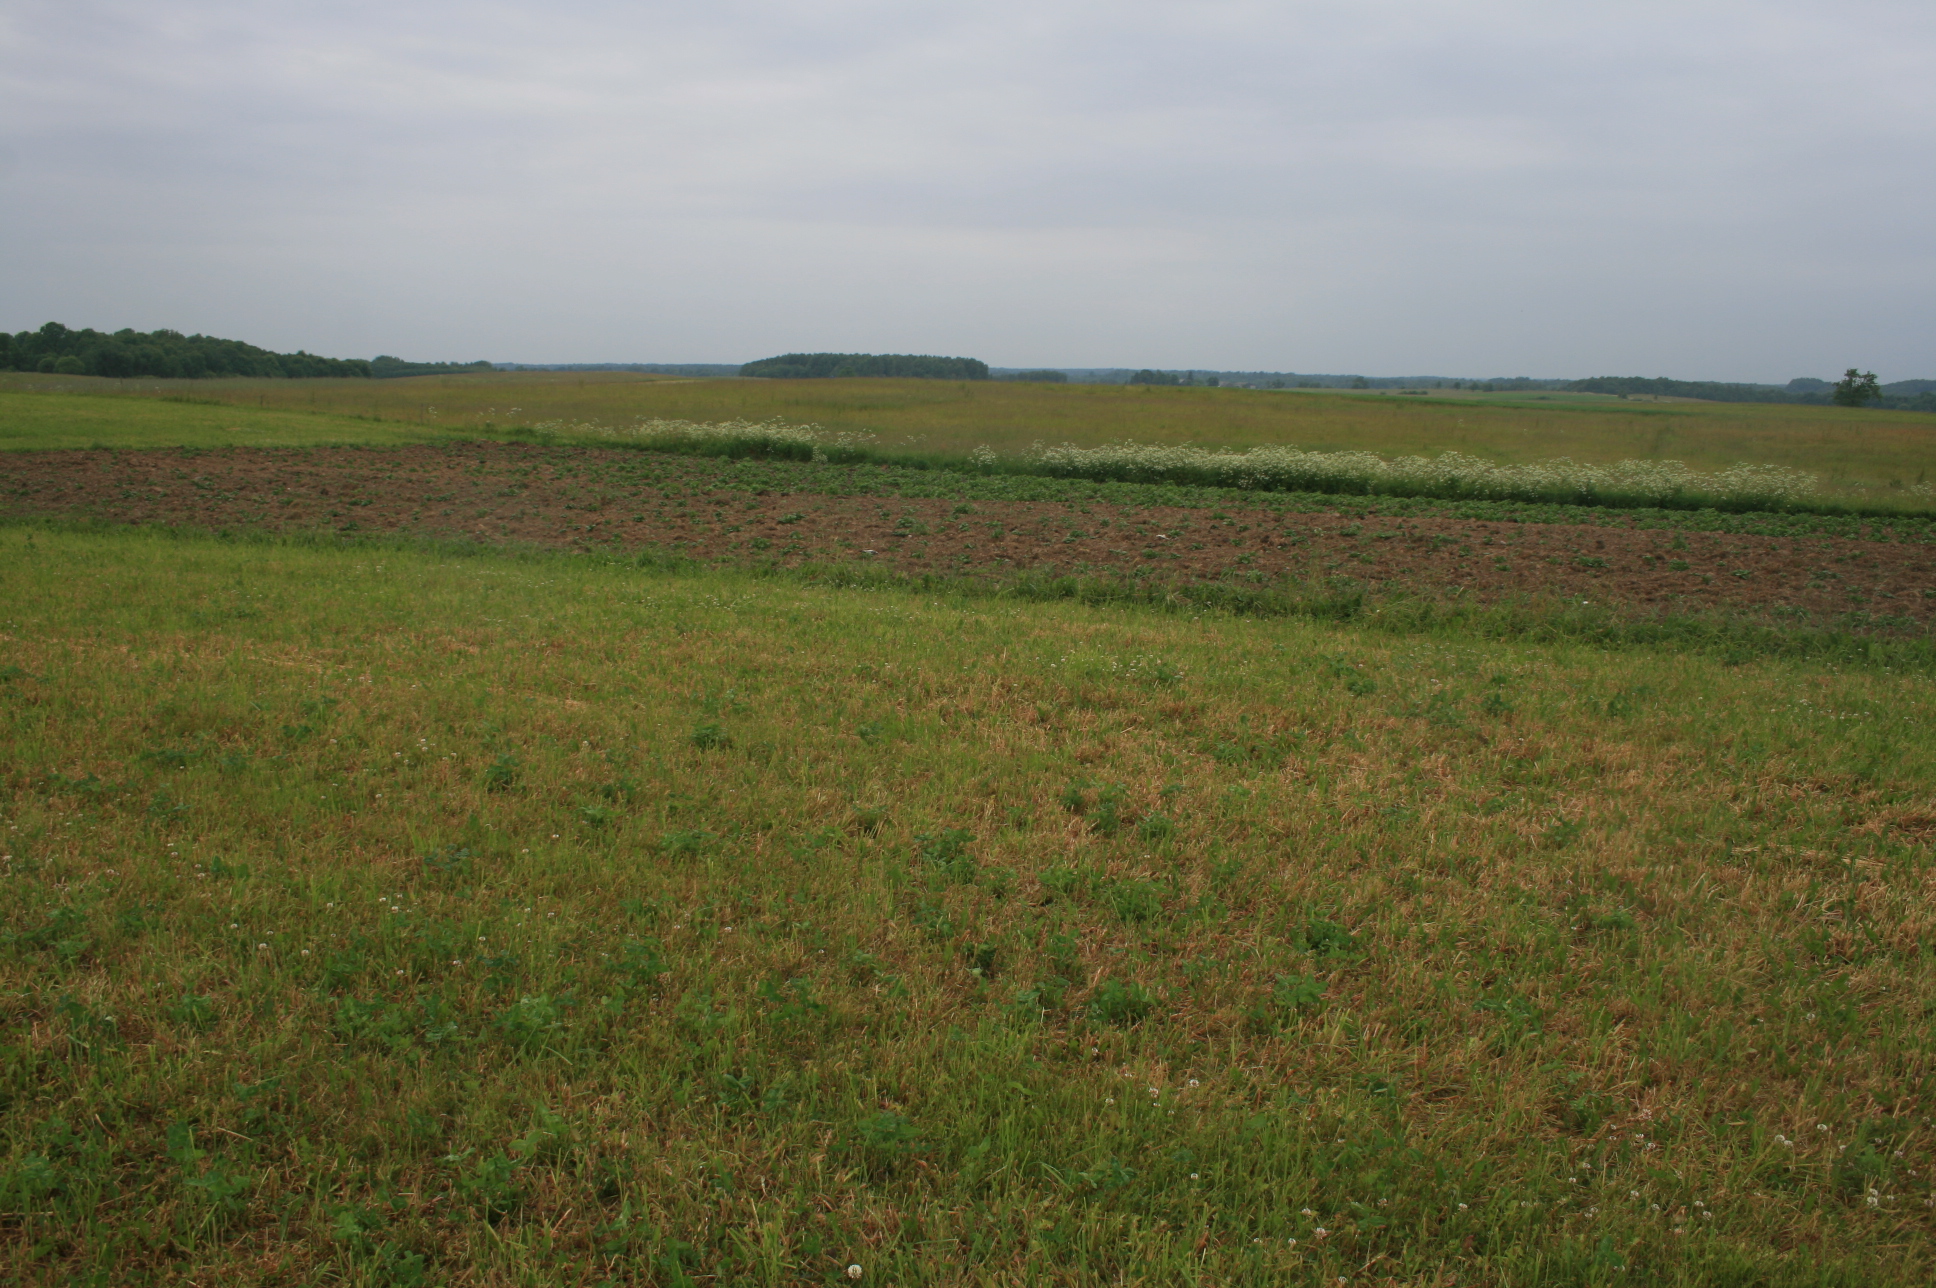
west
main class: Grassland
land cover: Grassland without tree/shrub cover
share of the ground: > 75 %
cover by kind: herbaceous plants 100 %
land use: Agriculture (excluding fallow land and kitchen gardens)
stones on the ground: < 10 %
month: June
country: LT
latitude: 55.4965
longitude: 22.3580
